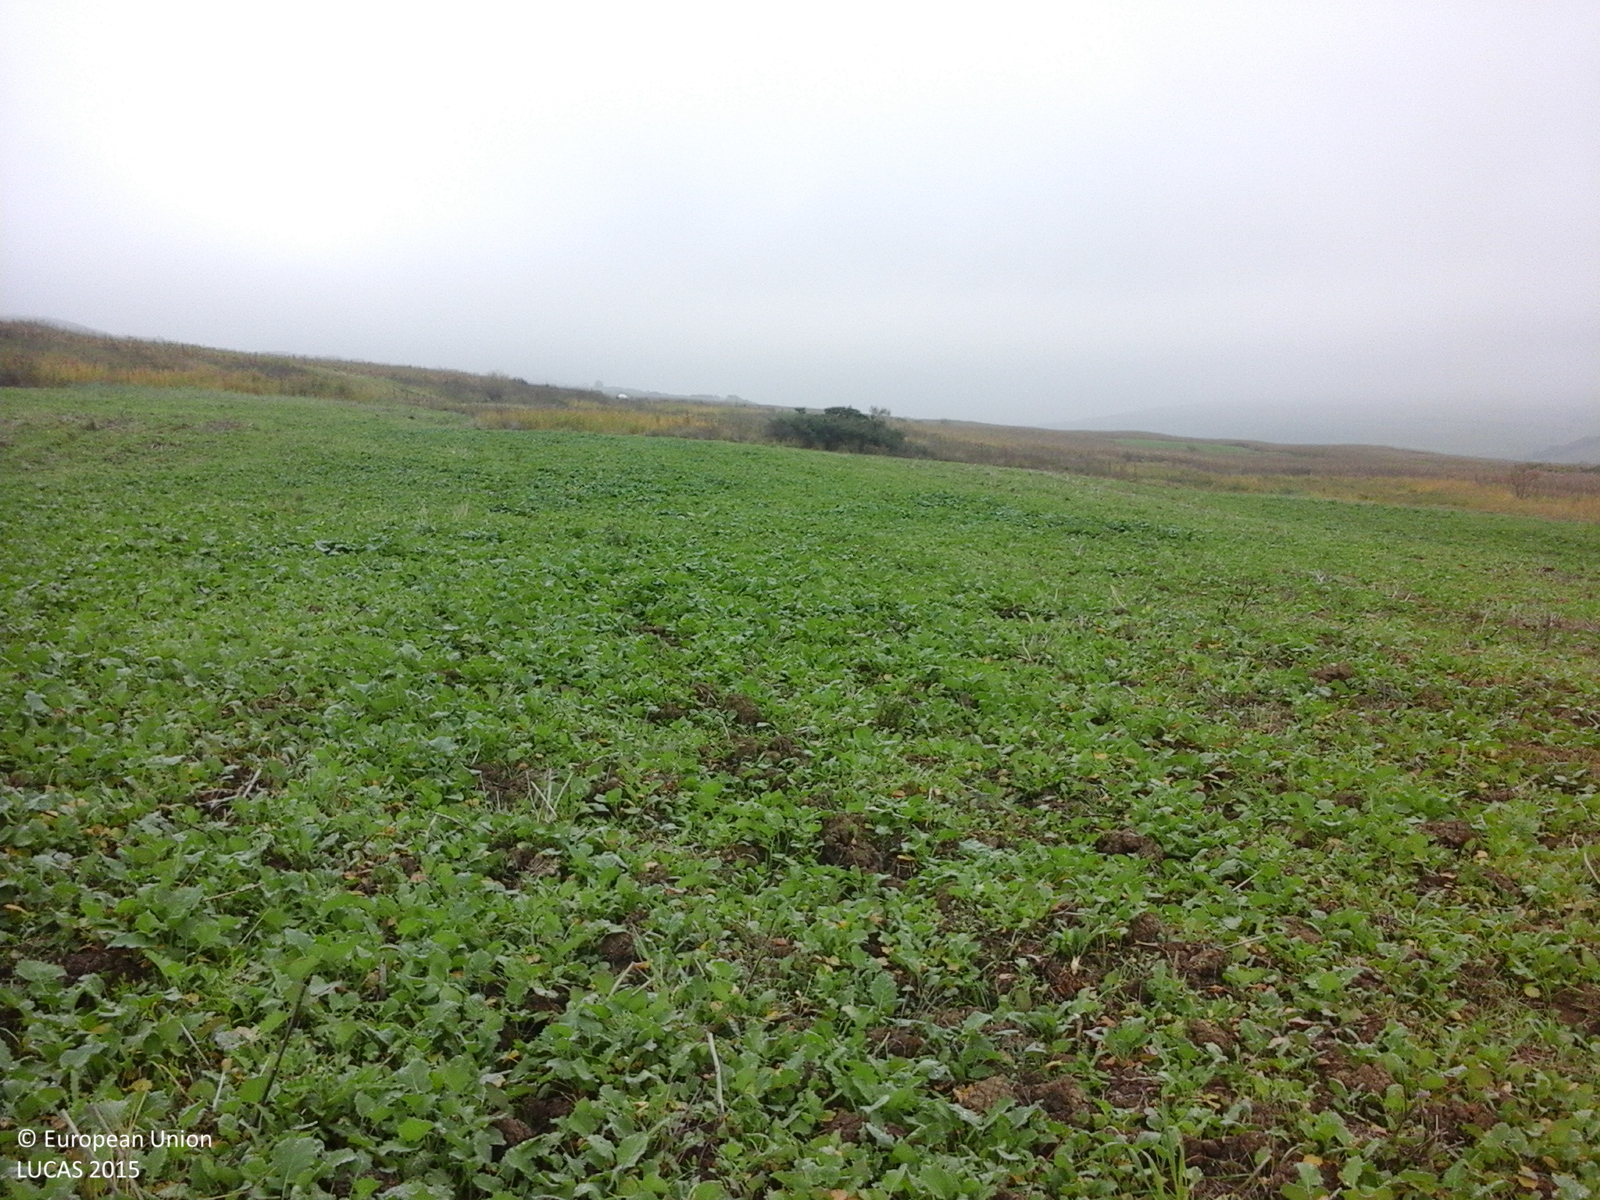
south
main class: Cropland
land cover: Rape and turnip rape
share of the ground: > 75 %
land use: Agriculture (excluding fallow land and kitchen gardens)
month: October
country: RO
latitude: 46.3938
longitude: 24.2698
